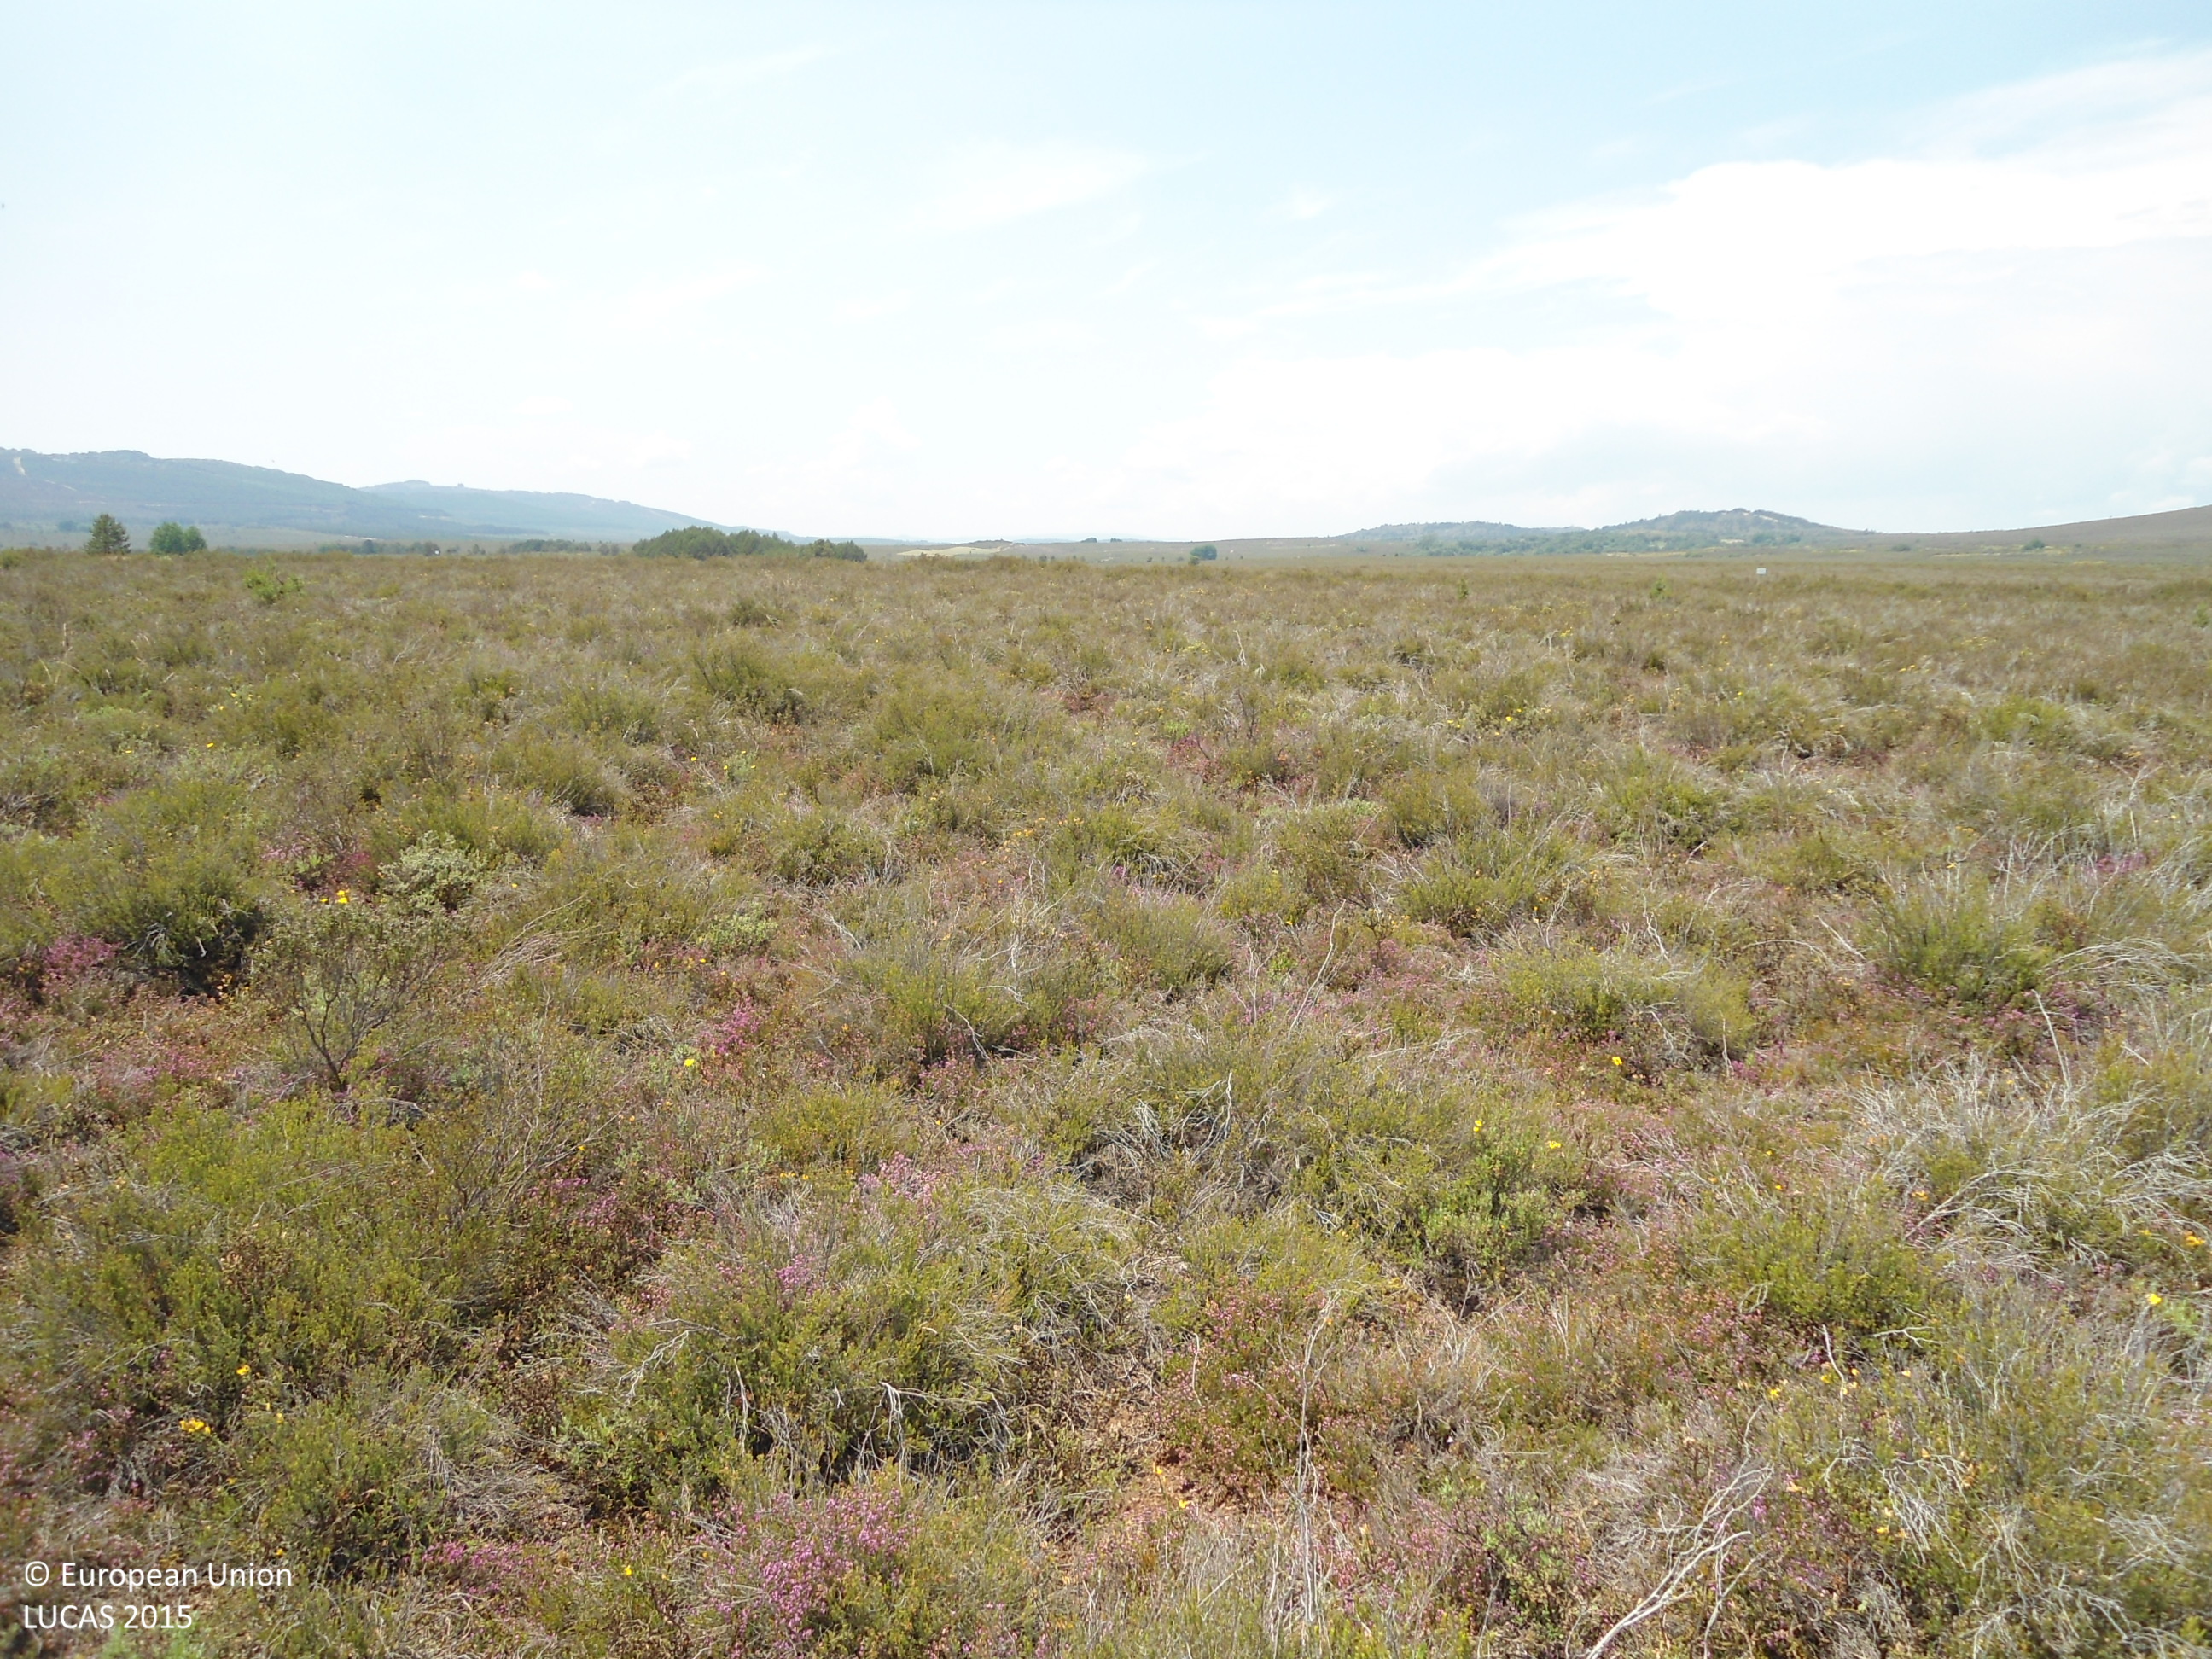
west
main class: Shrubland
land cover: Shrubland without tree cover
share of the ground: > 75 %
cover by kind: shrubs 100 %
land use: Semi-natural and natural areas not in use
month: June
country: ES
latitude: 41.9398
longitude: -6.3523
